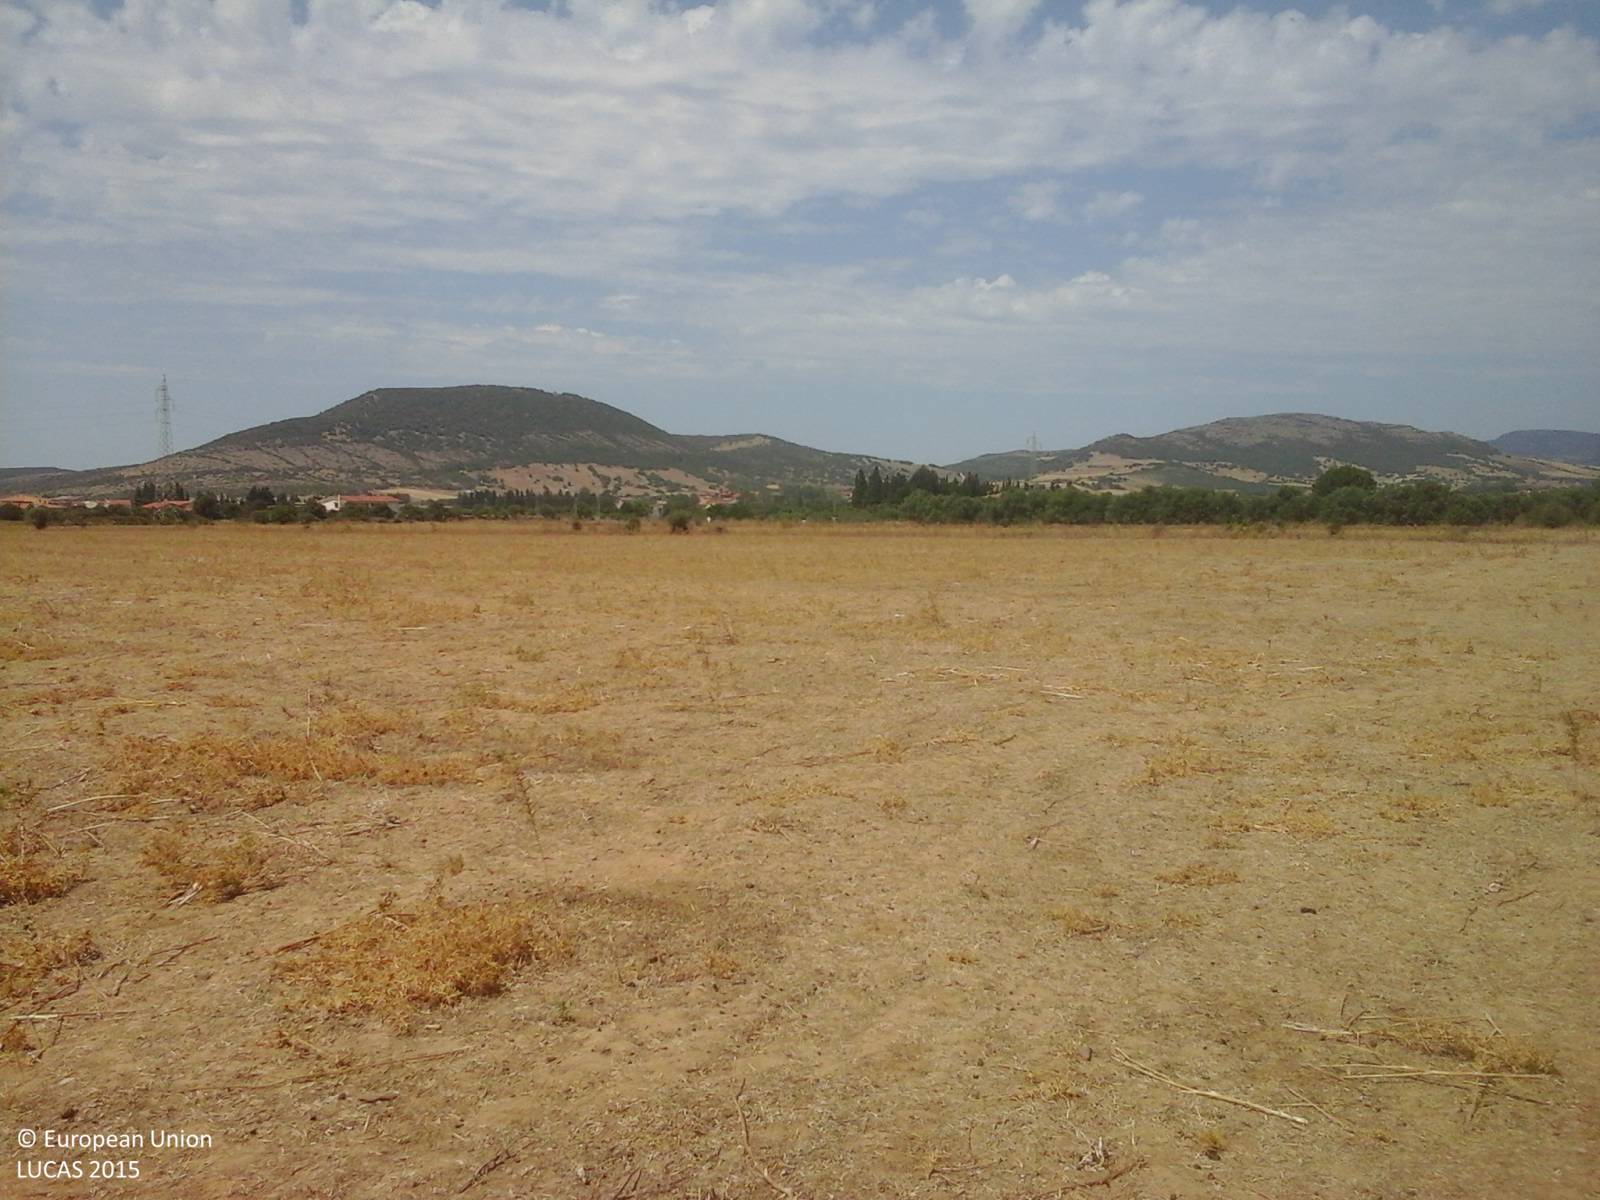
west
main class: Grassland
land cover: Grassland without tree/shrub cover
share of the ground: > 75 %
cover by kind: herbaceous plants 75 %, unconsolidated bare surface 20 %, consolidated bare surface 5 %
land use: Agriculture (excluding fallow land and kitchen gardens)
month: July
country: IT
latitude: 39.1172
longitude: 8.6783
